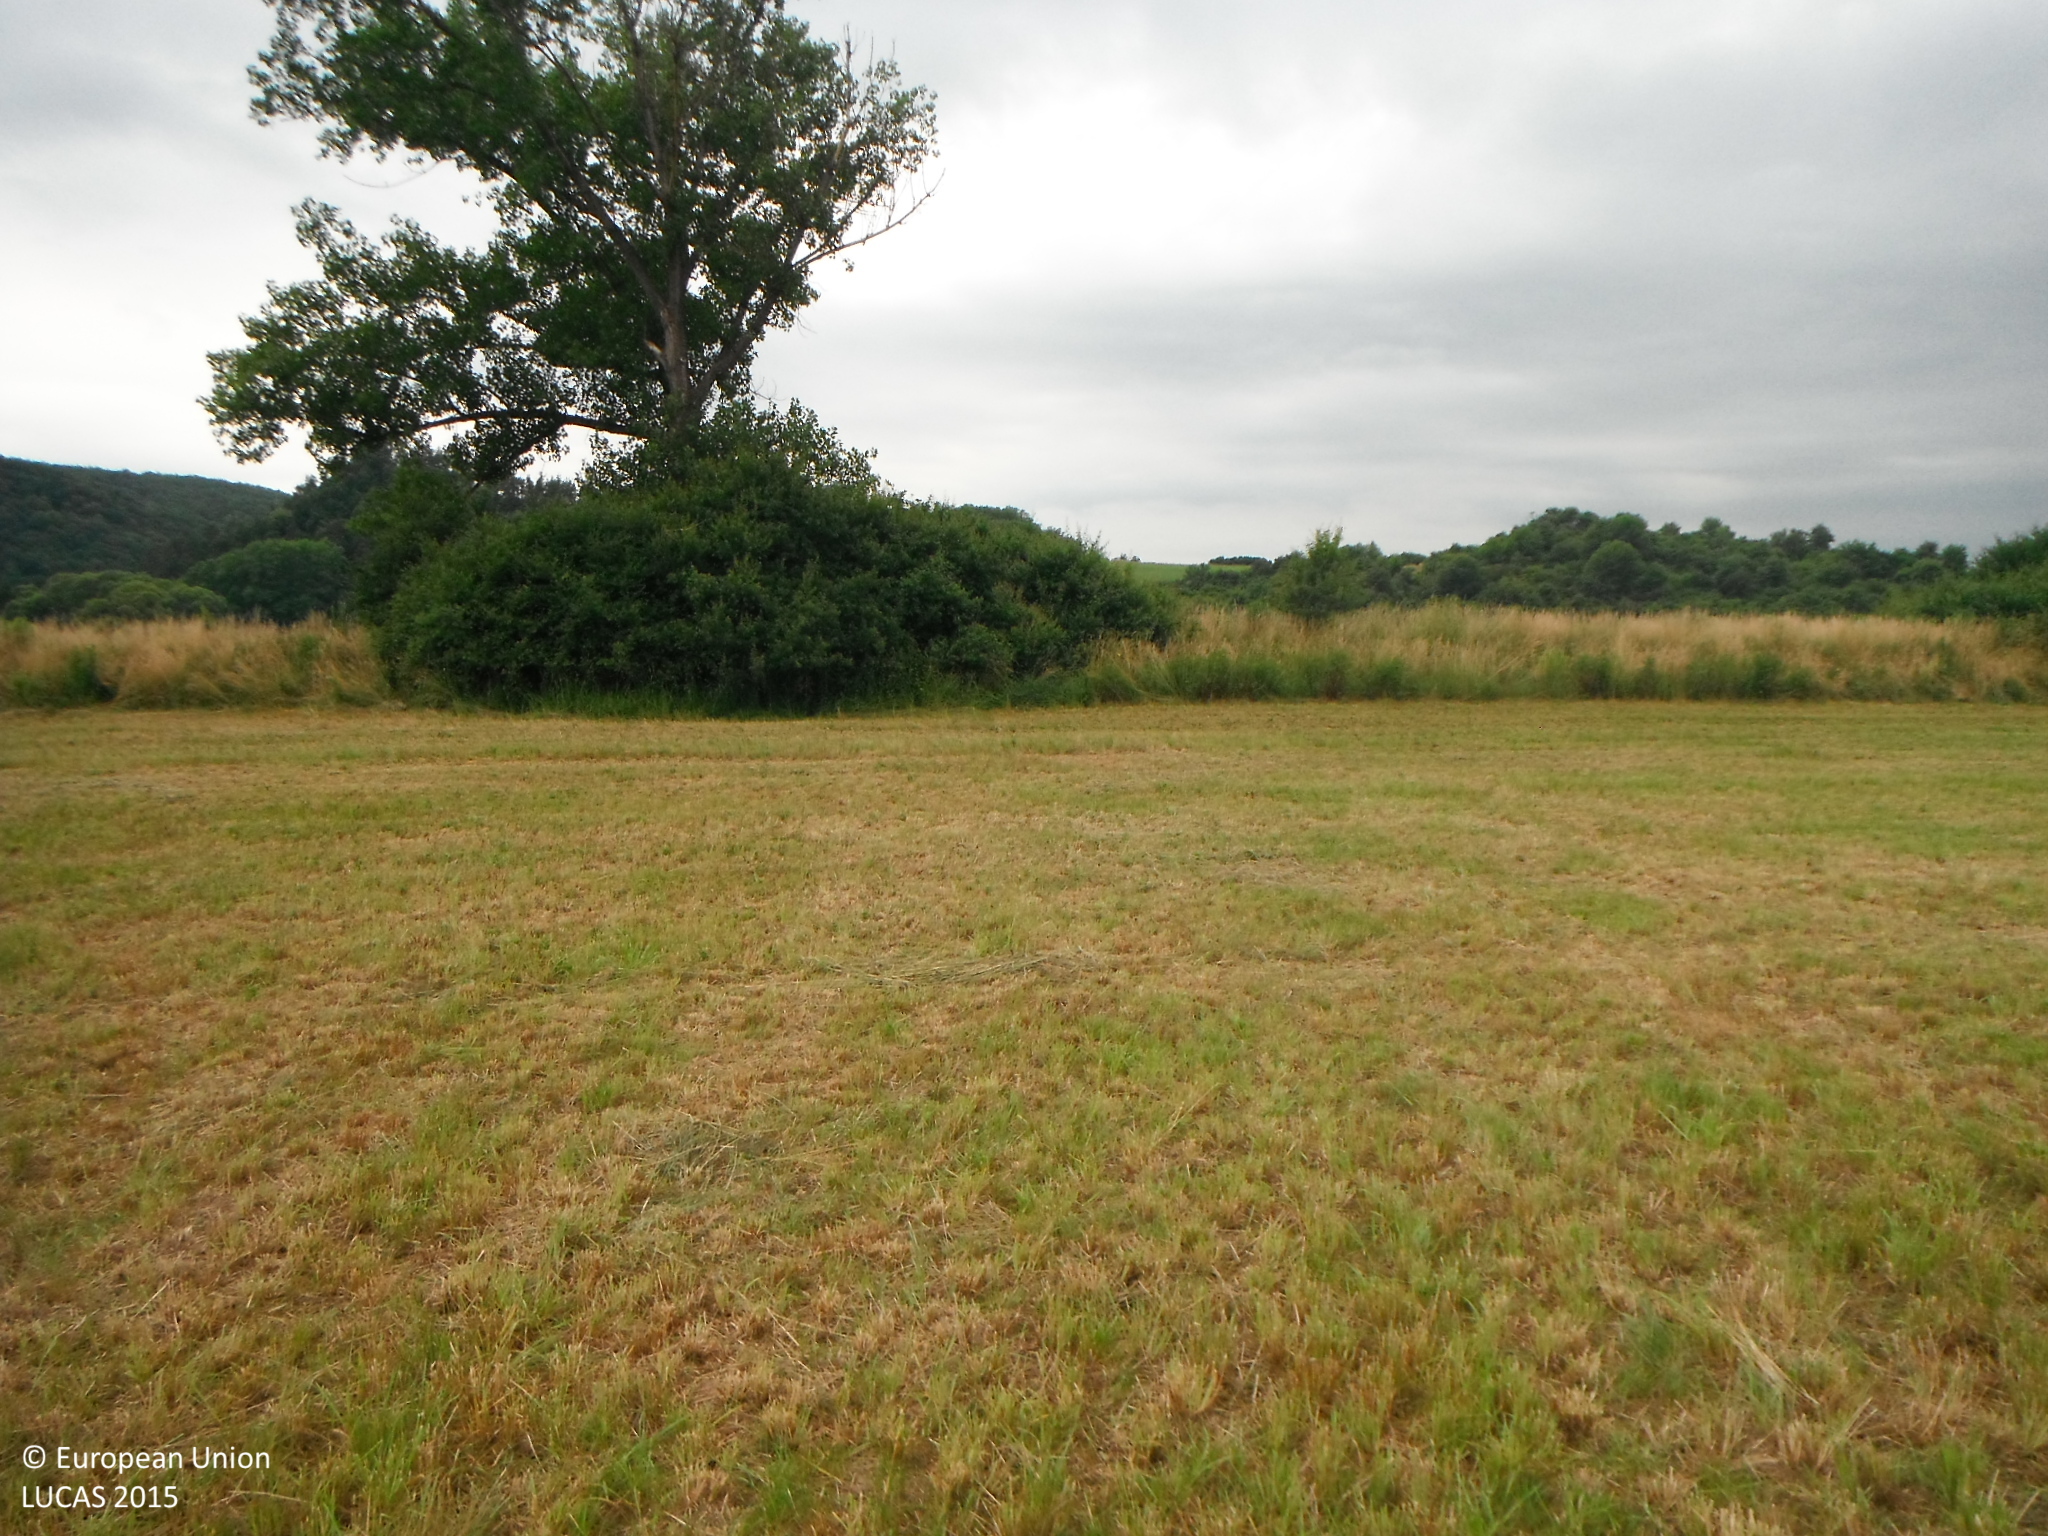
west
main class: Grassland
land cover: Grassland without tree/shrub cover
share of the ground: > 75 %
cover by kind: herbaceous plants 100 %
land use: Agriculture (excluding fallow land and kitchen gardens)
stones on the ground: < 10 %
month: June
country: SK
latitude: 48.5583
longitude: 19.2498
